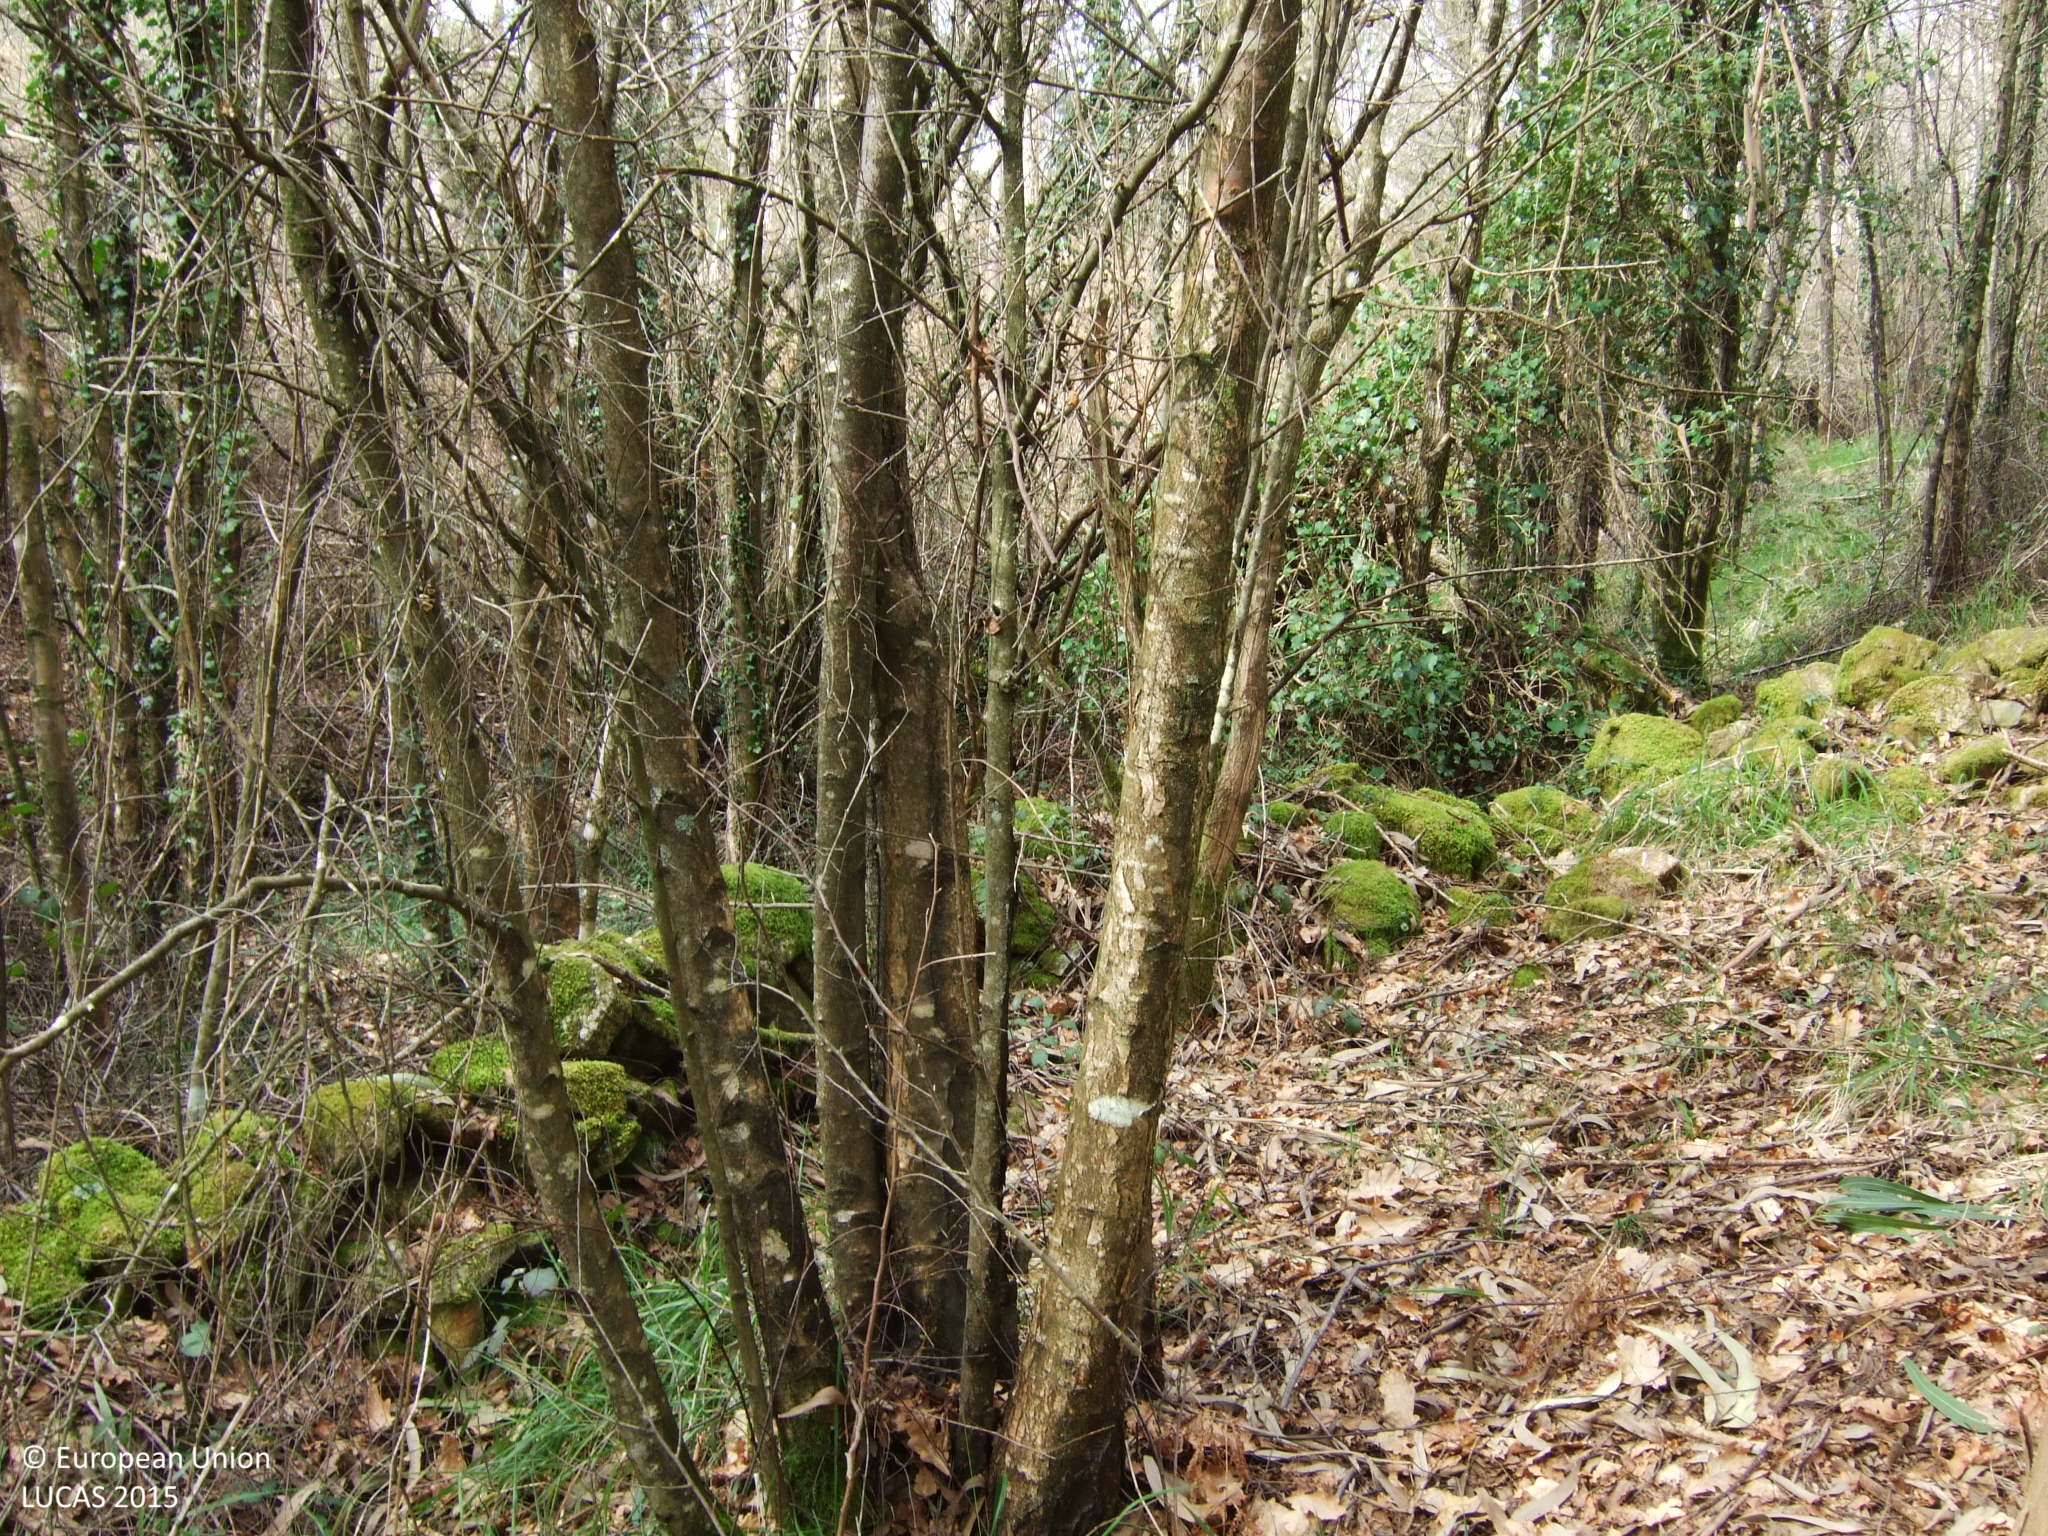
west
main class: Woodland
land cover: Broadleaved woodland
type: exotic forest
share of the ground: > 75 %
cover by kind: broadleaved forest trees 90 %, shrubs 10 %
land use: Forestry
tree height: > 5 m
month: March
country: ES
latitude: 42.9238
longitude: -7.9123
